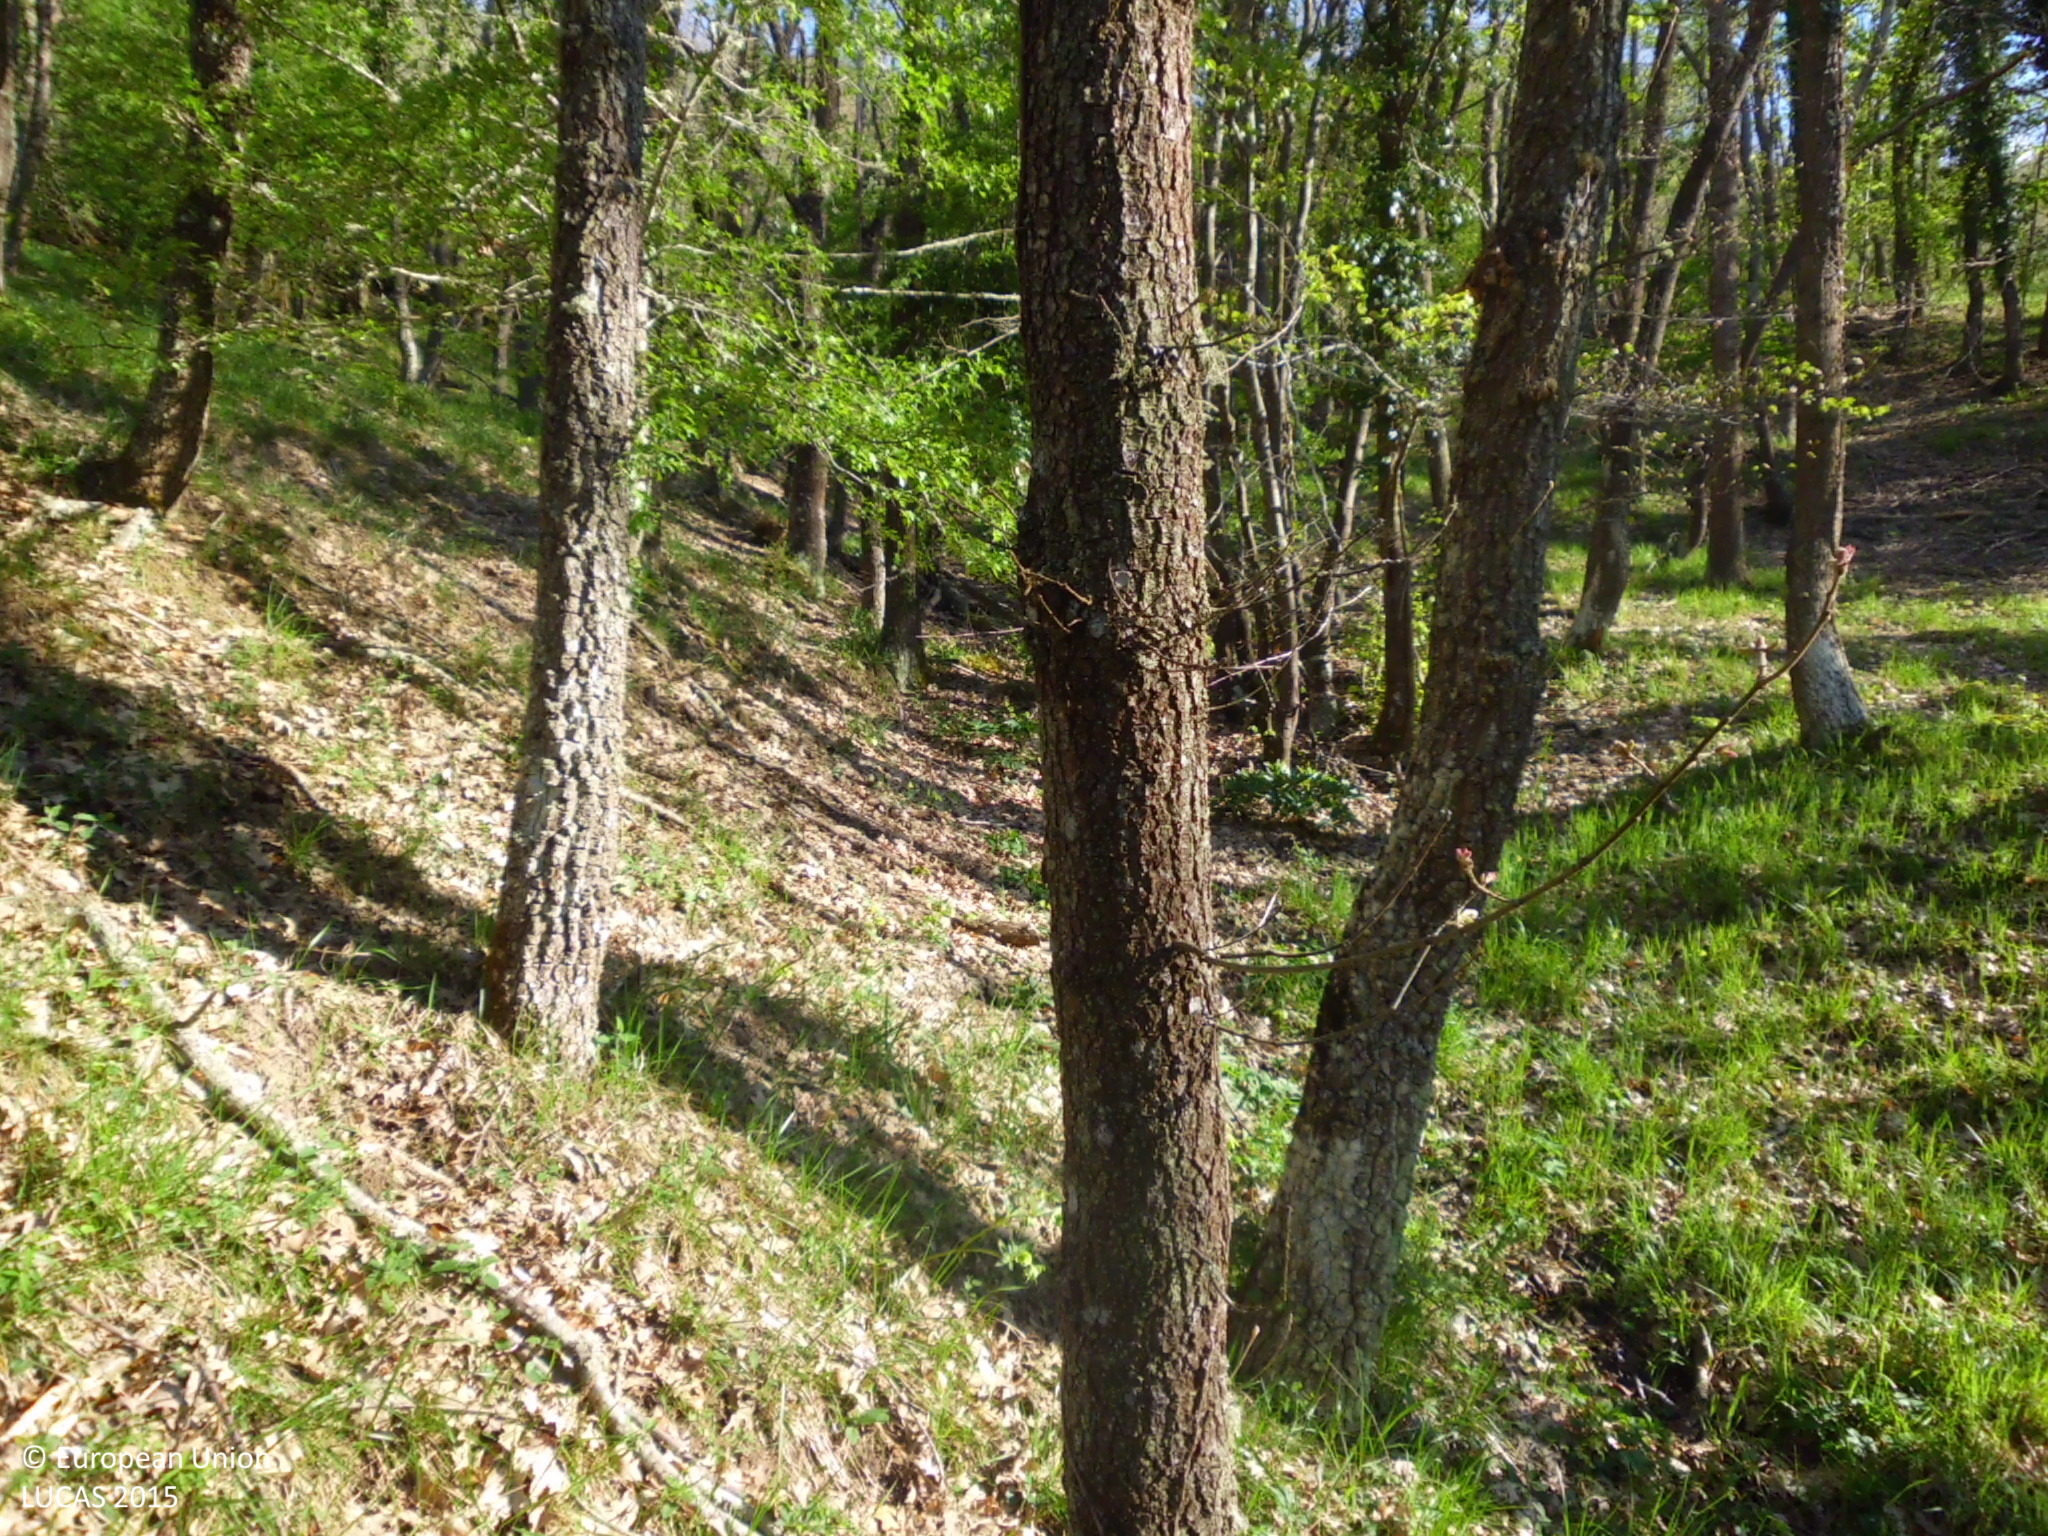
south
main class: Woodland
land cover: Broadleaved woodland
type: acidophilous oak and oak-birch forest
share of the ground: > 75 %
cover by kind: broadleaved forest trees 90 %, herbaceous plants 10 %
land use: Semi-natural and natural areas not in use
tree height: > 5 m
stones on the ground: 10 - 25 %
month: May
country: ES
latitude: 42.7721
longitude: -4.0151
